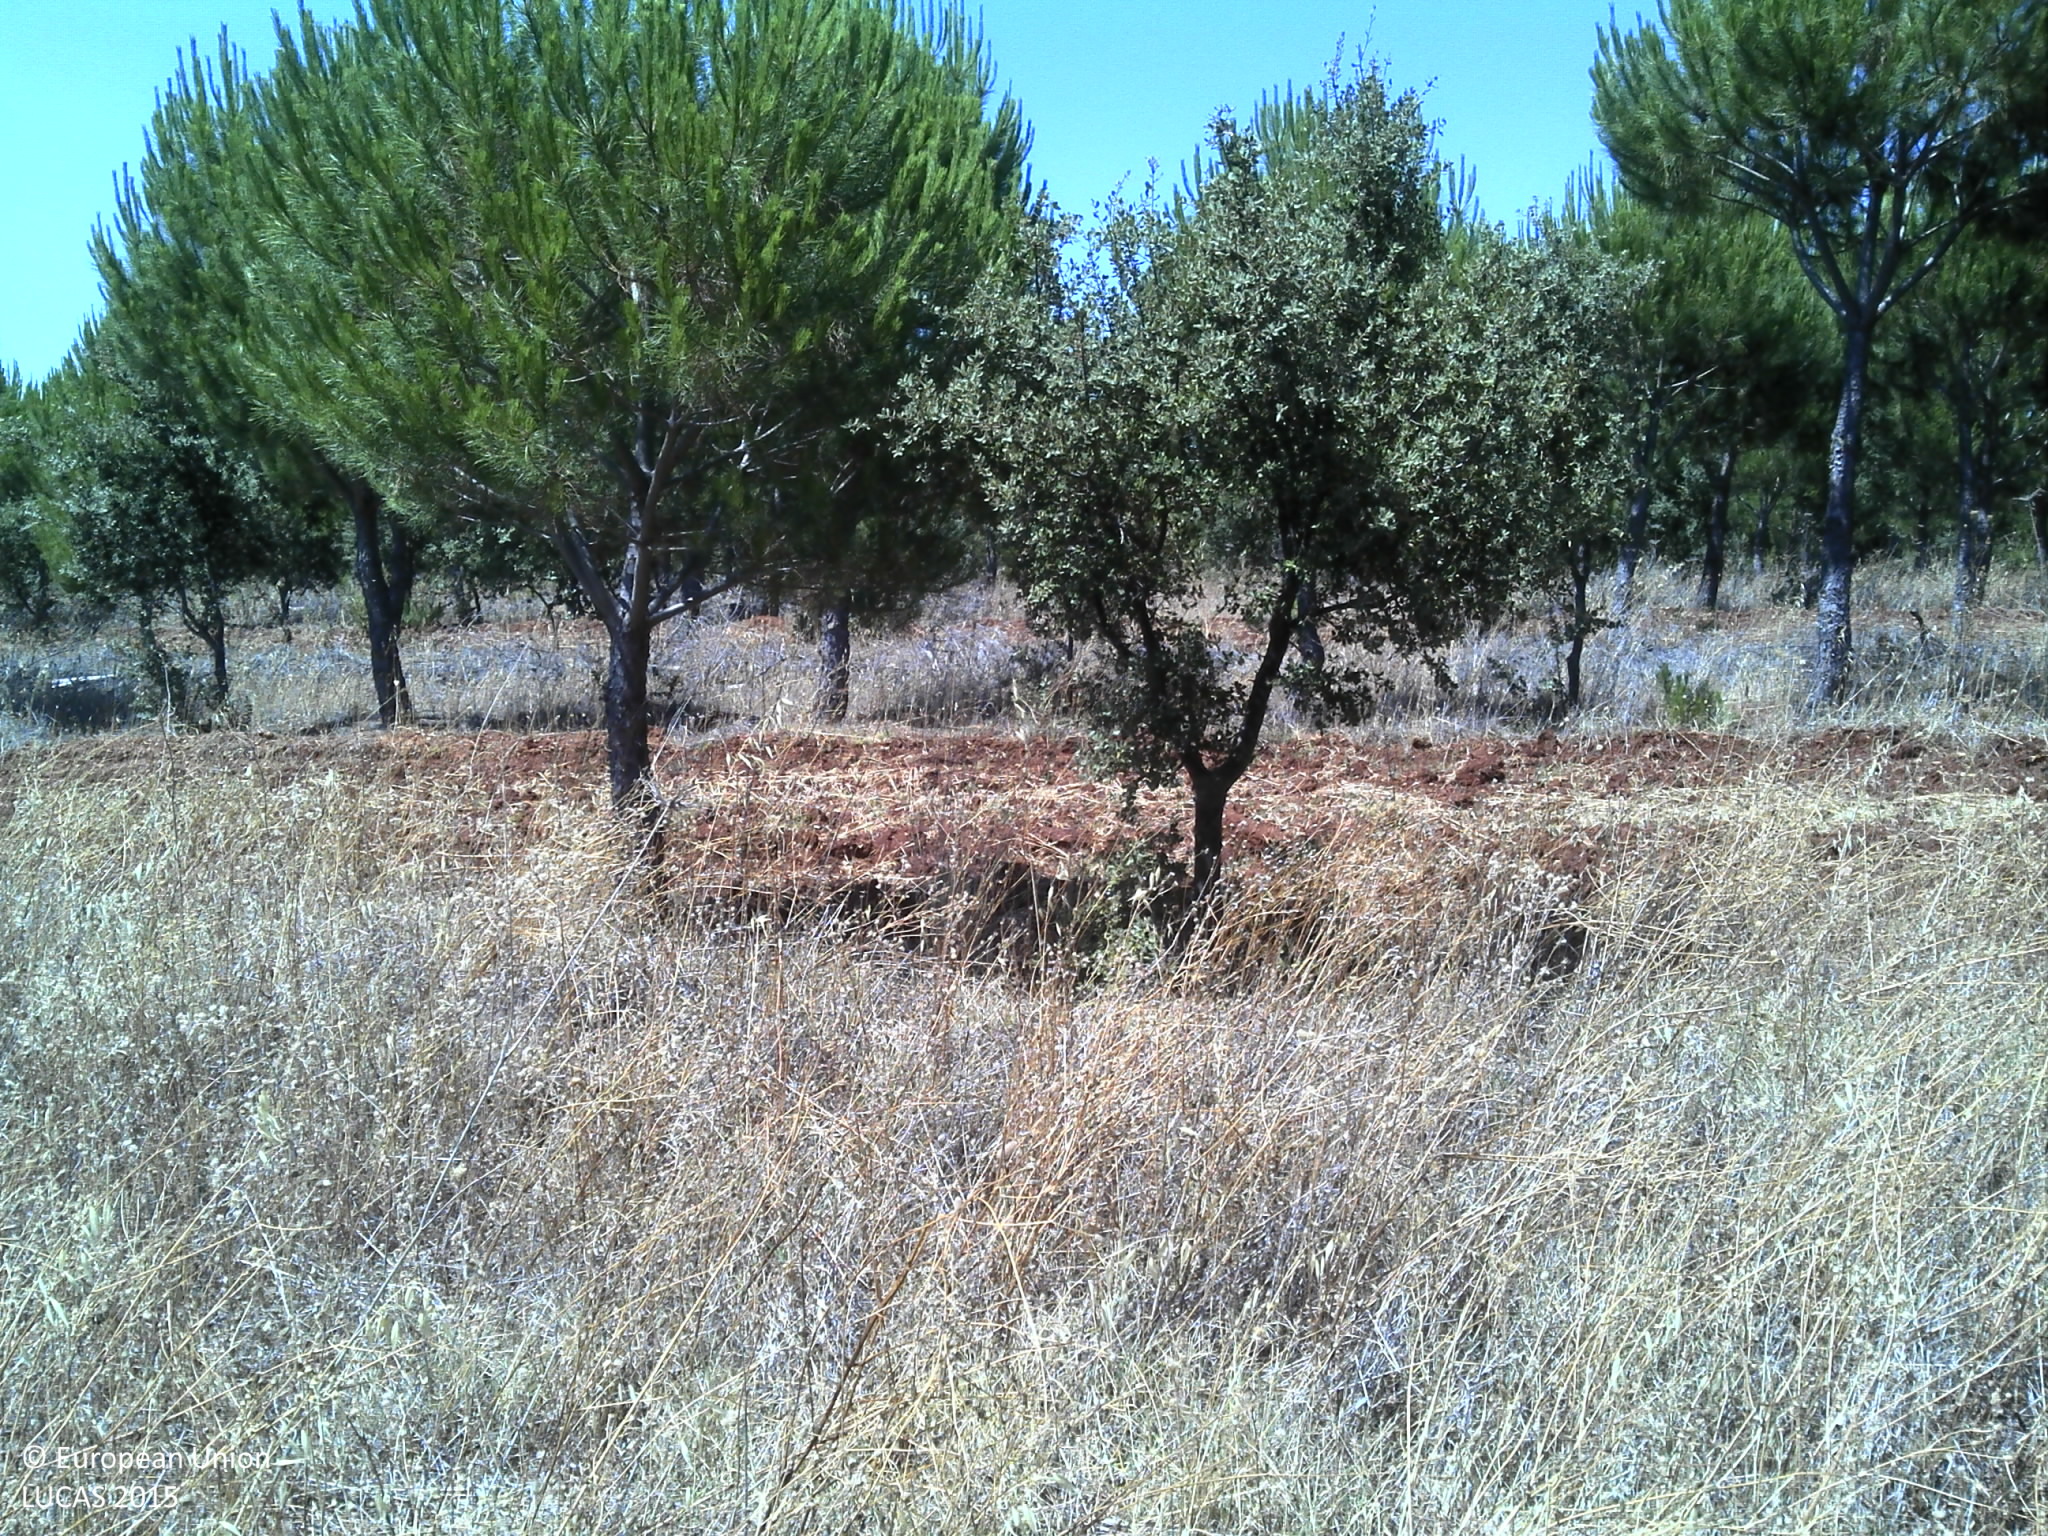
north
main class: Woodland
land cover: Pine dominated mixed woodland
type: coniferous forest of the mediterranean region
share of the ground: 50 - 75 %
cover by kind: coniferous forest trees 50 %, broadleaved forest trees 20 %, herbaceous plants 15 %, unconsolidated bare surface 15 %
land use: Forestry
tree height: < 5 m
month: July
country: PT
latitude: 38.1359
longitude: -7.3488
